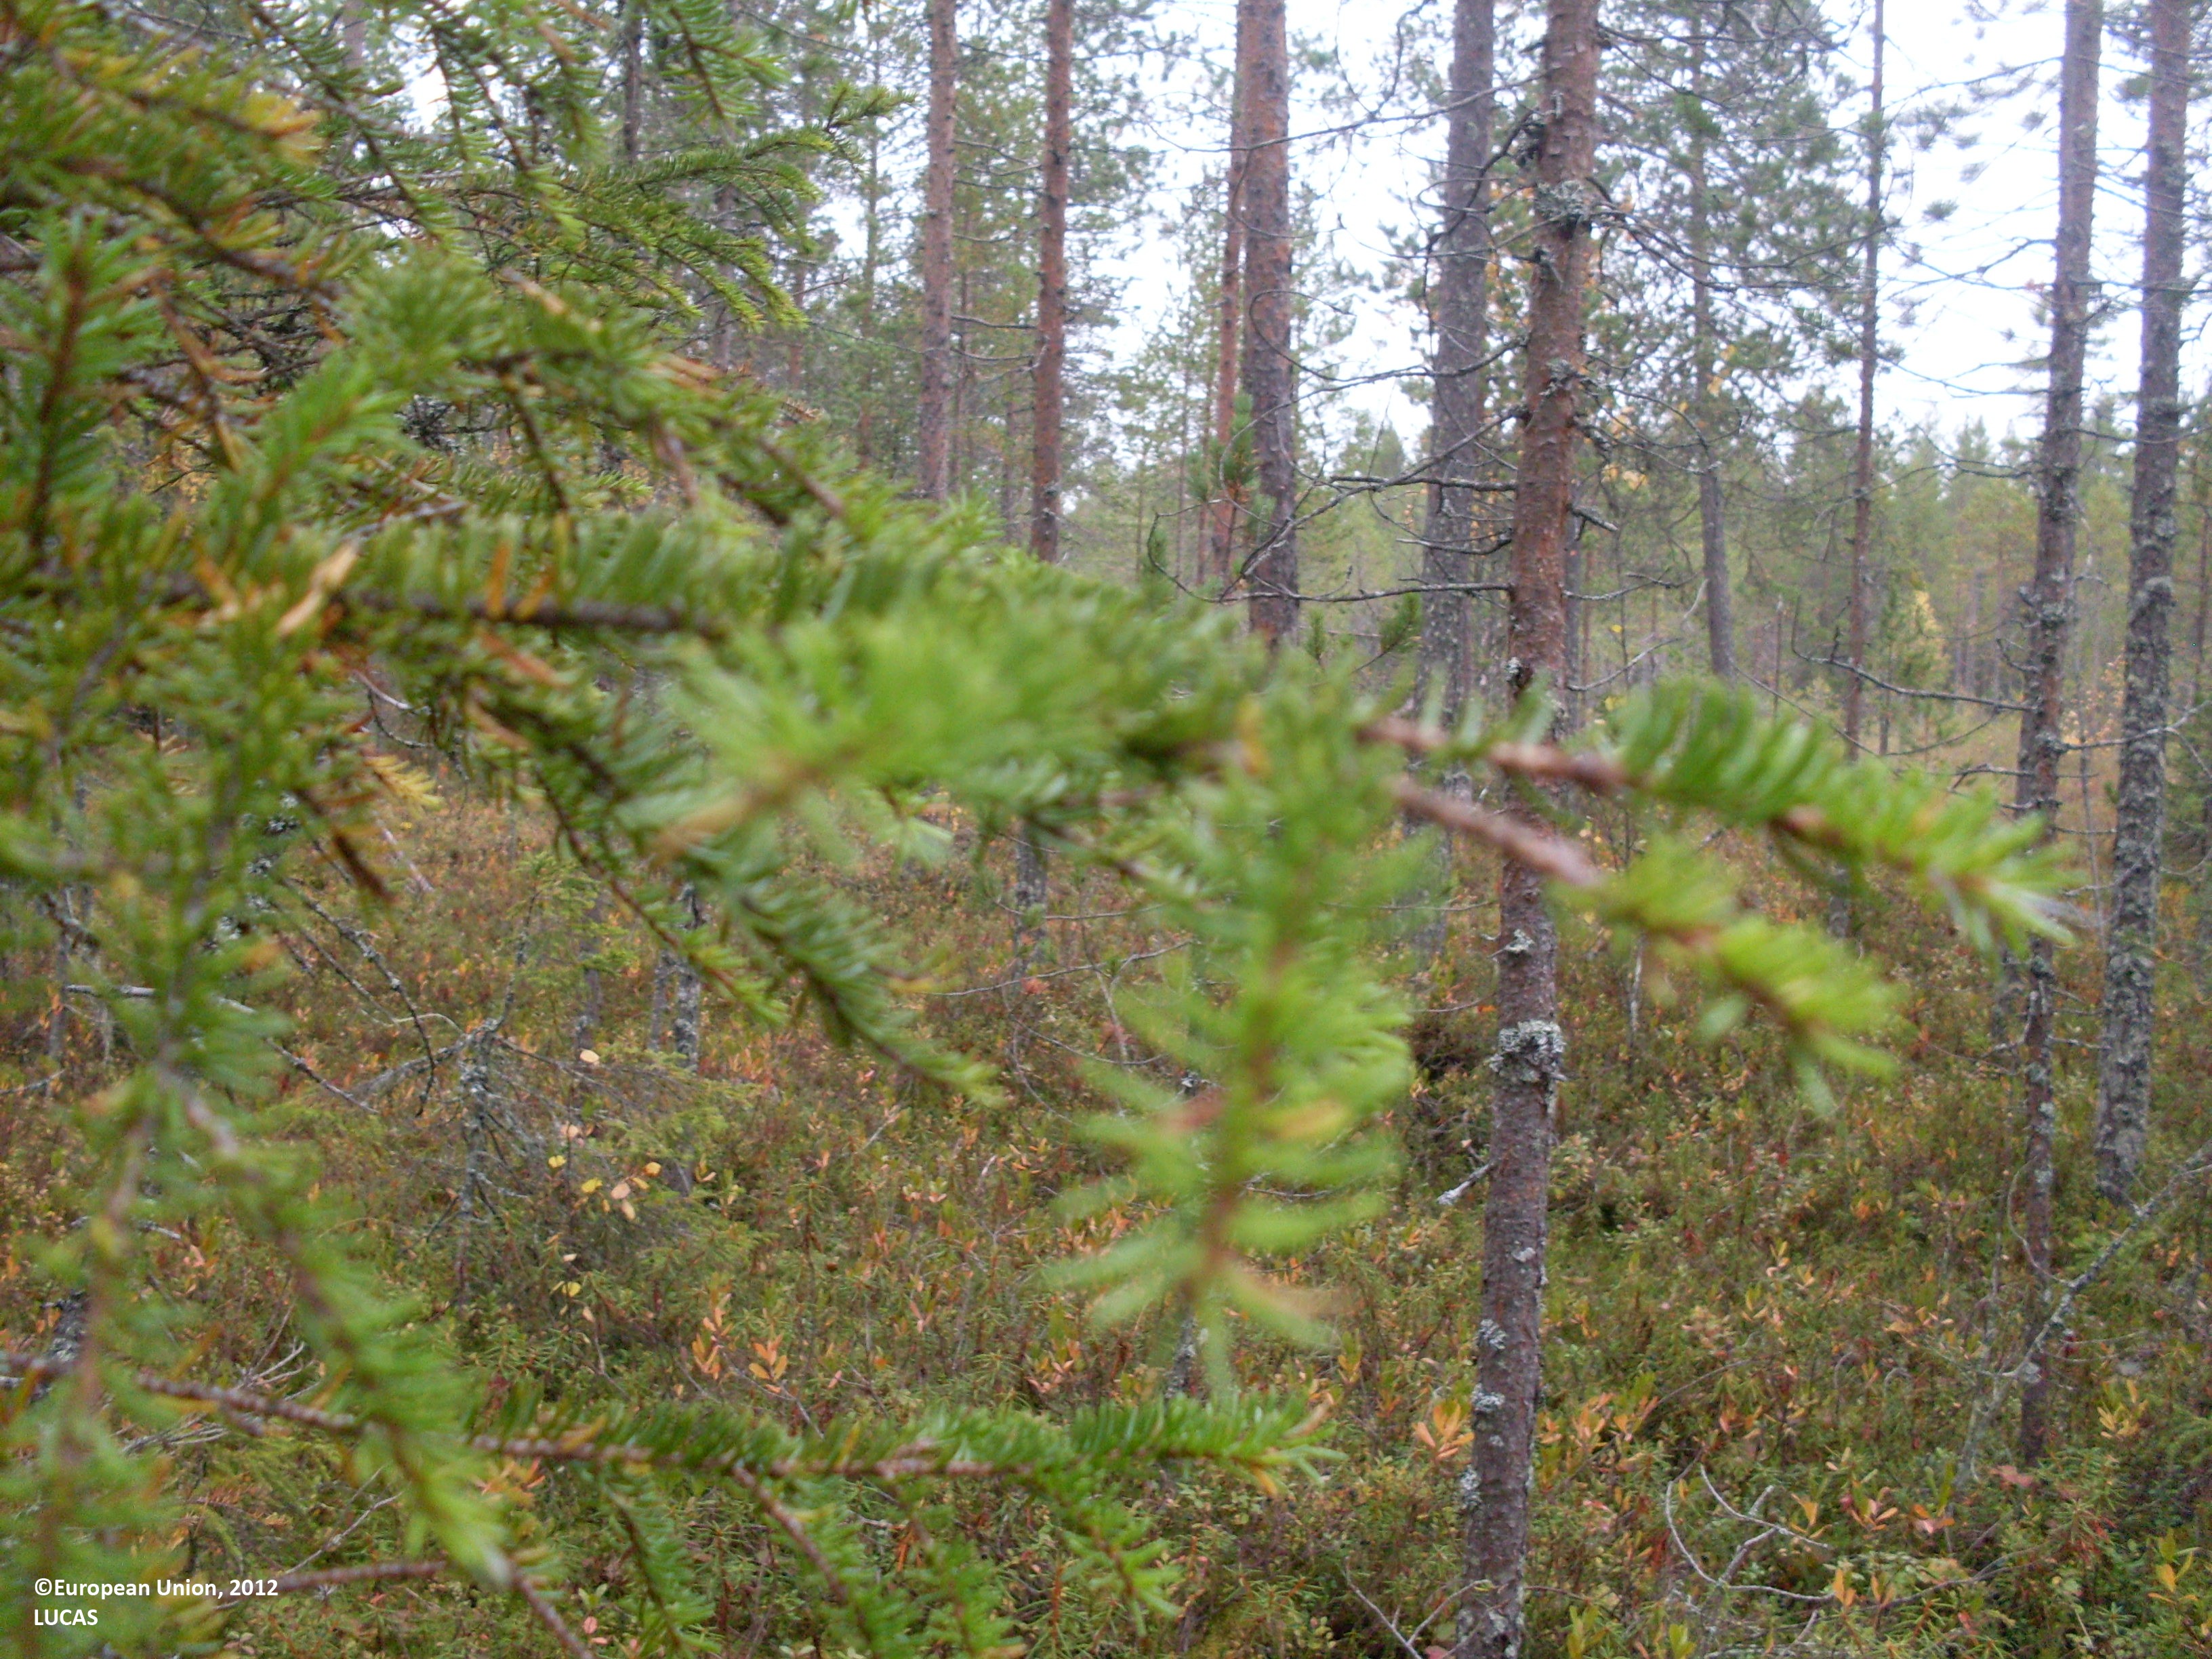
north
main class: Woodland
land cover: Pine dominated coniferous woodland
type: boreal forest
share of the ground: 50 - 75 %
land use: Forestry
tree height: > 5 m
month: September
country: FI
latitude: 64.2021
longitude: 29.4725
